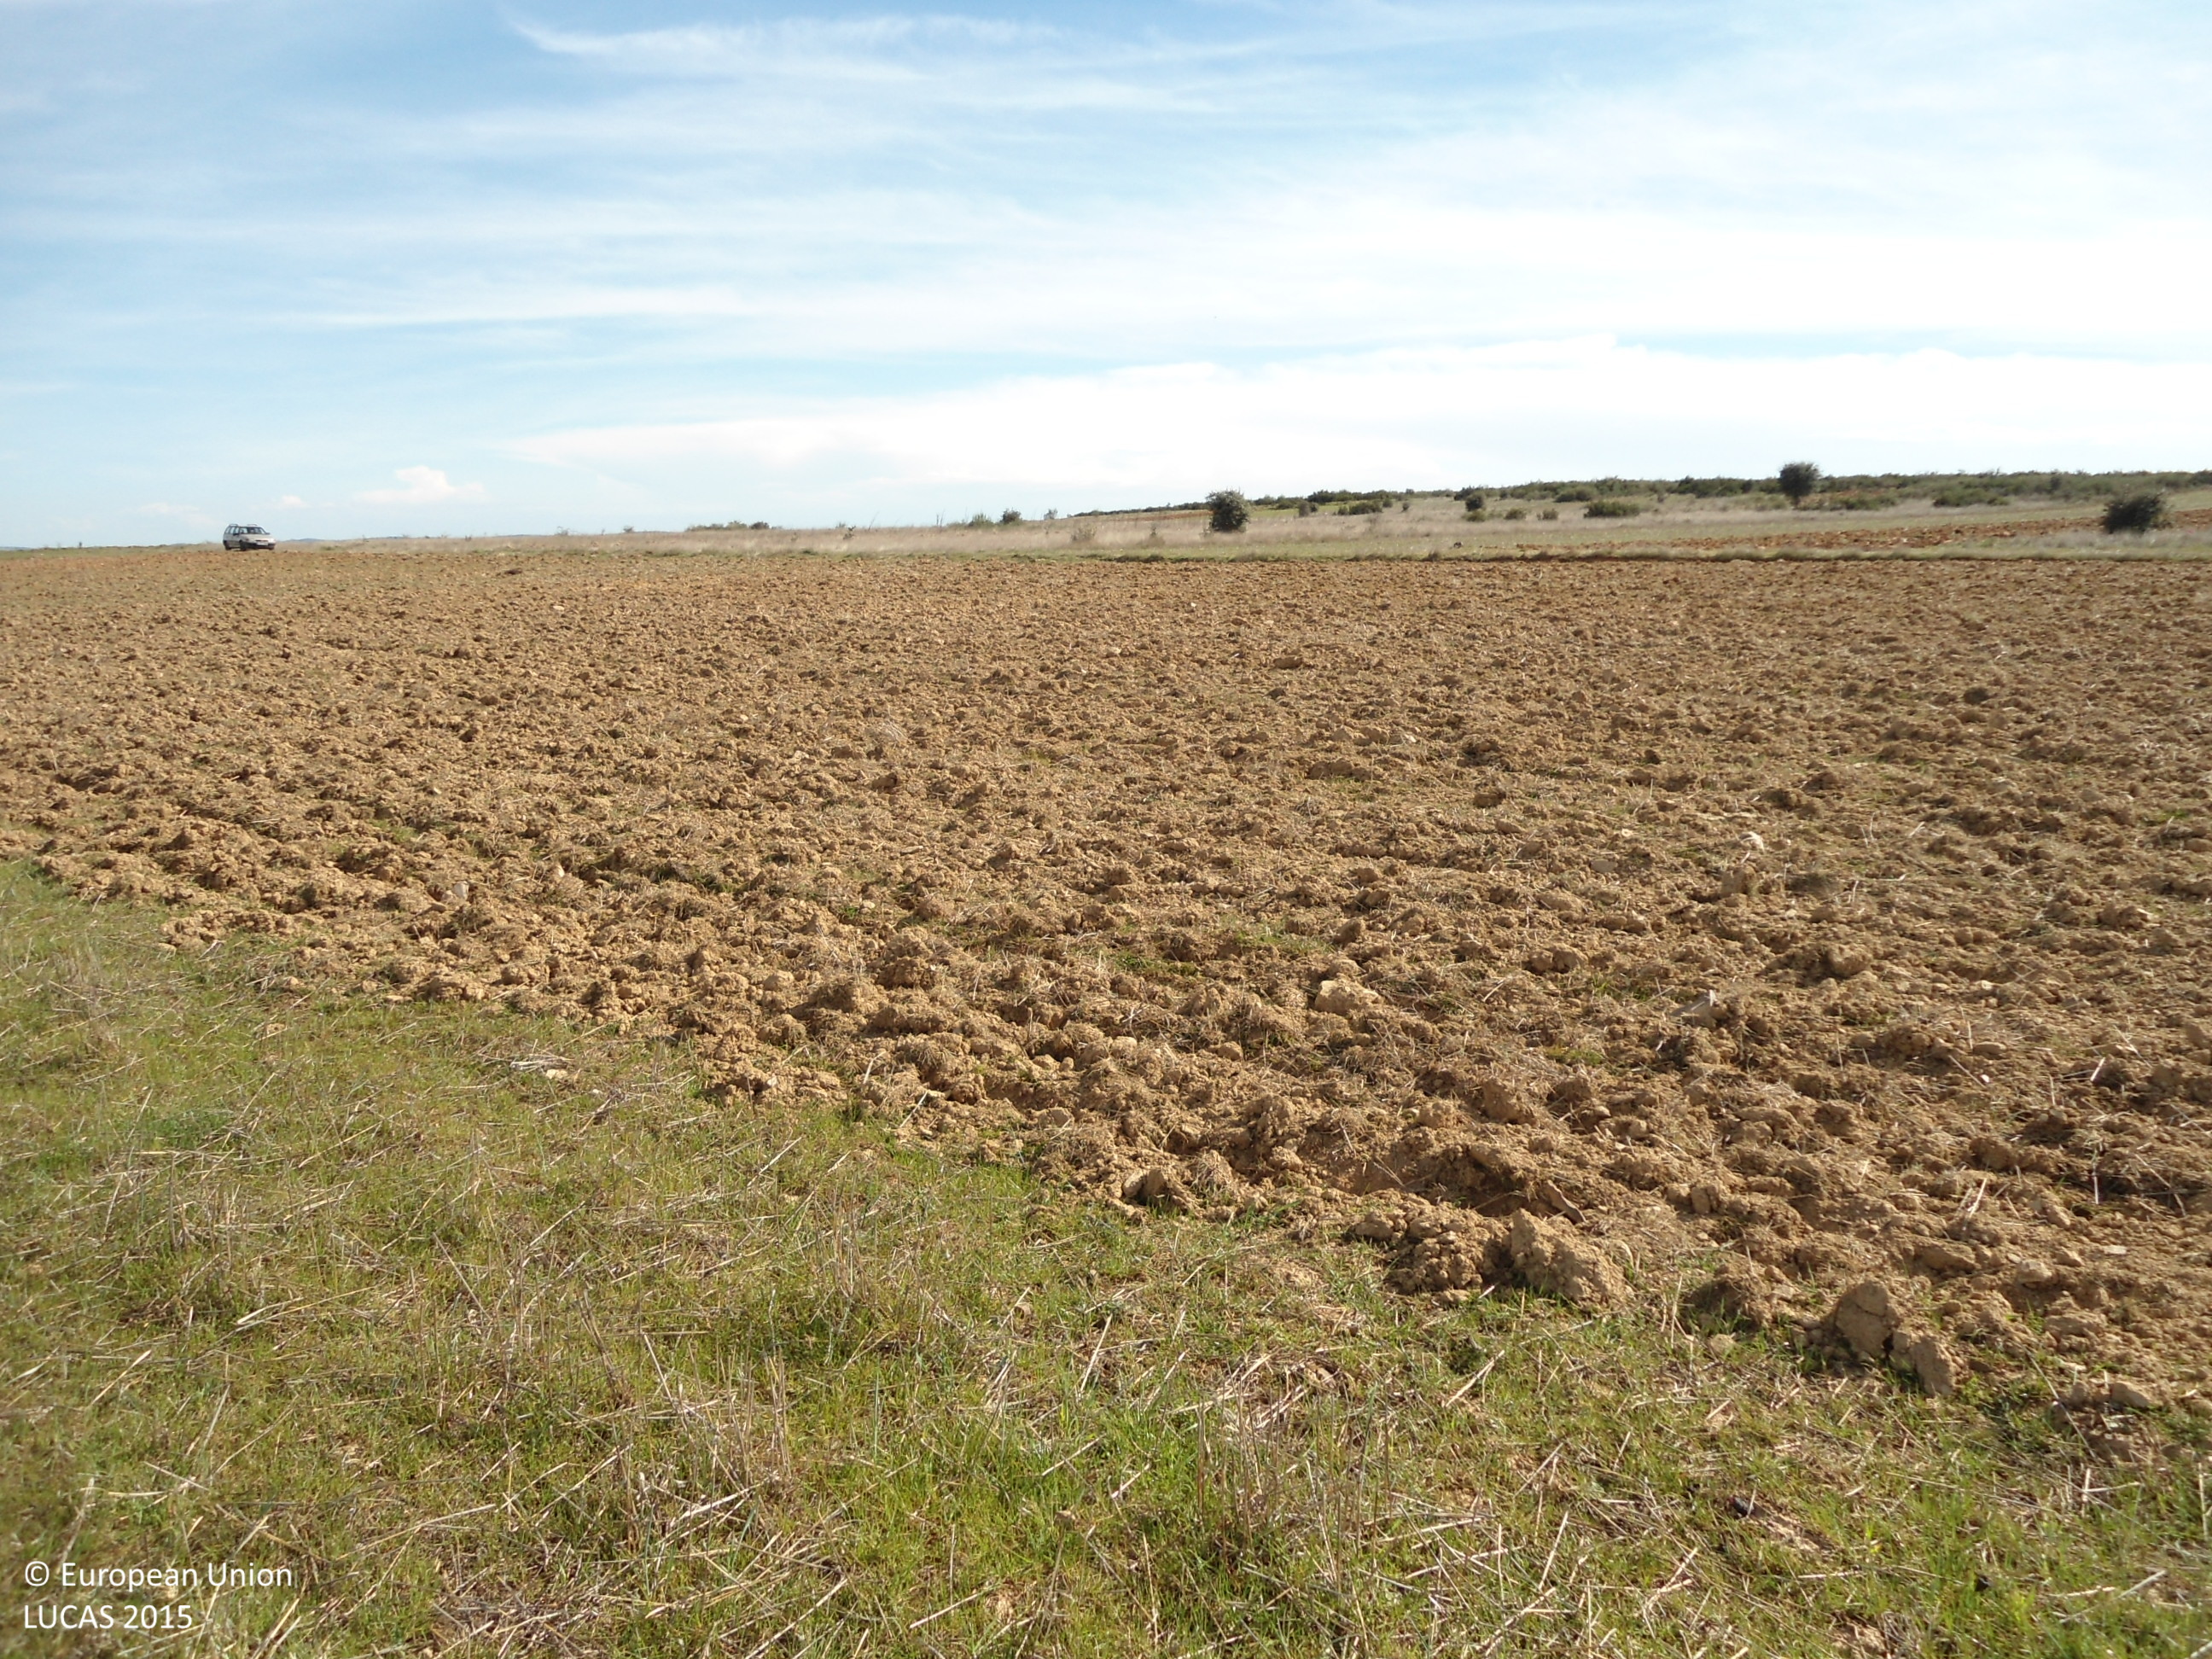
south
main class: Grassland
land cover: Spontaneously vegetated surfaces
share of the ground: > 75 %
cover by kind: herbaceous plants 100 %
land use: Agriculture (excluding fallow land and kitchen gardens)
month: April
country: ES
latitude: 41.7518
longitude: -6.1535
